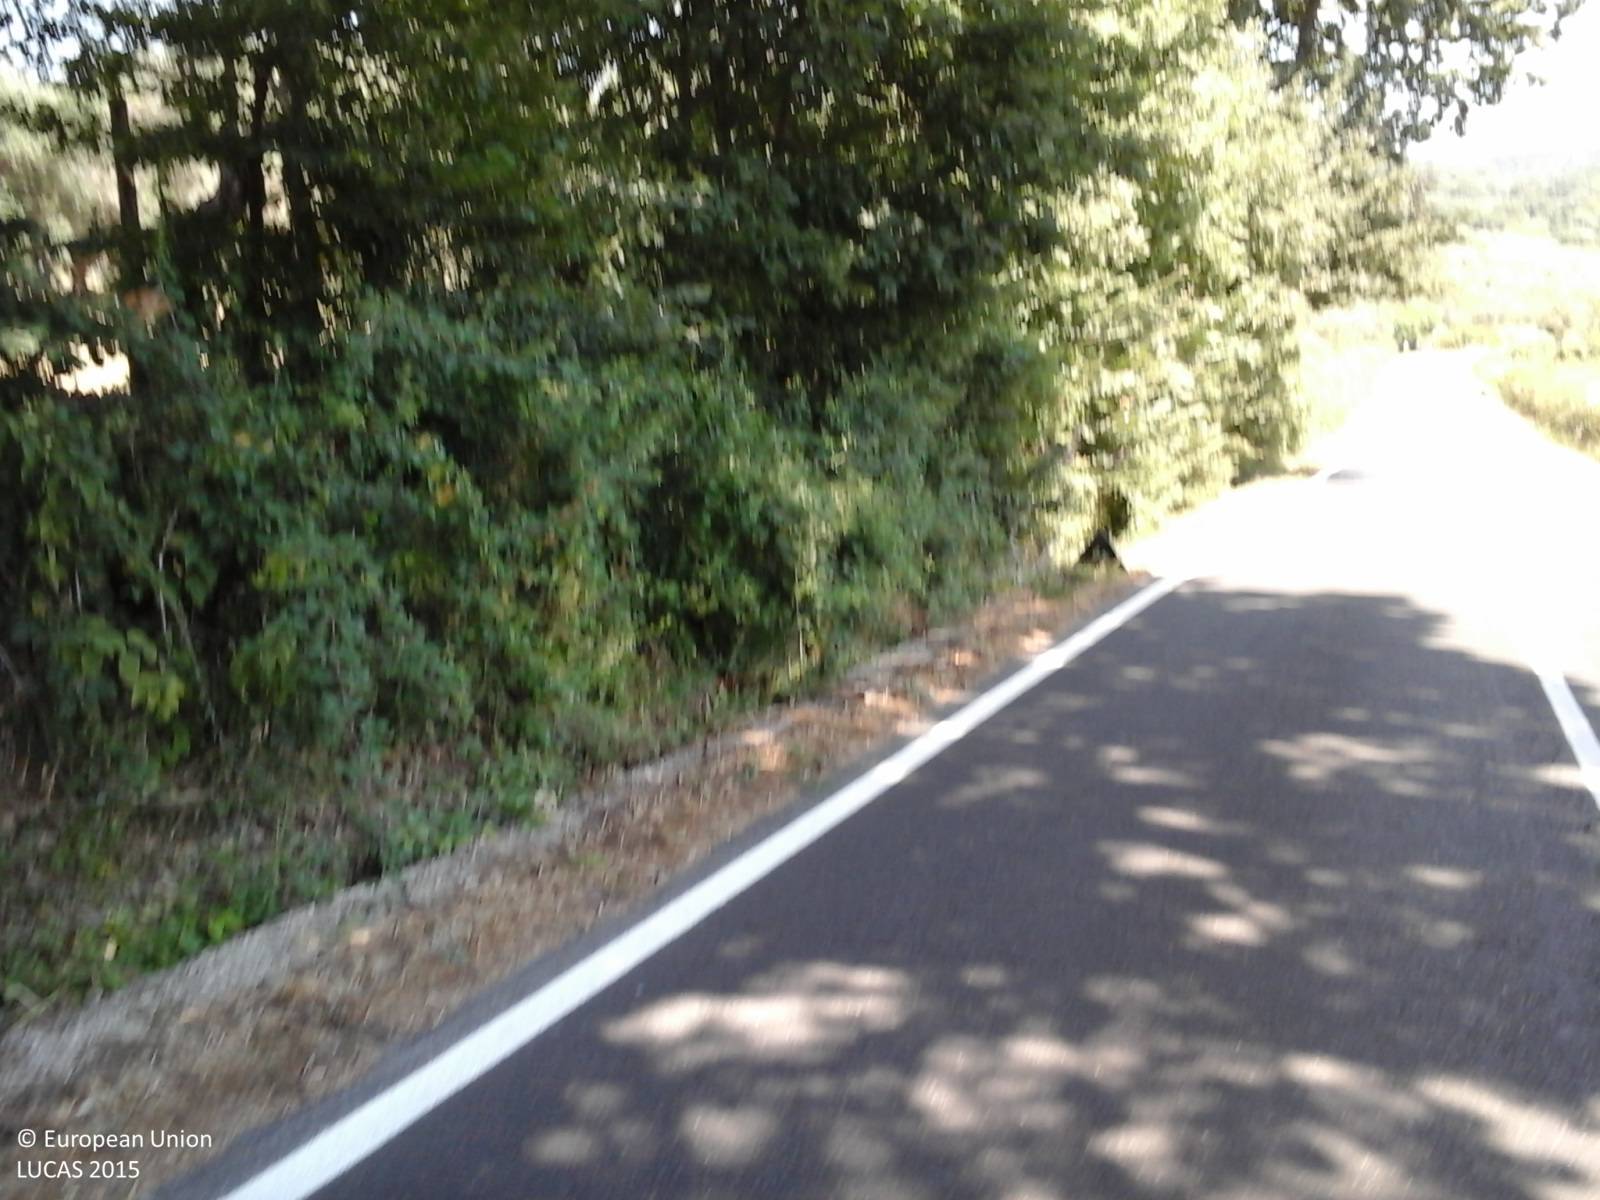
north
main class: Cropland
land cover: Olive groves
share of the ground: > 75 %
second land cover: Spontaneously vegetated surfaces
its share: > 75 %
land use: Agriculture (excluding fallow land and kitchen gardens)
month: August
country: IT
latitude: 42.1602
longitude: 12.2070
